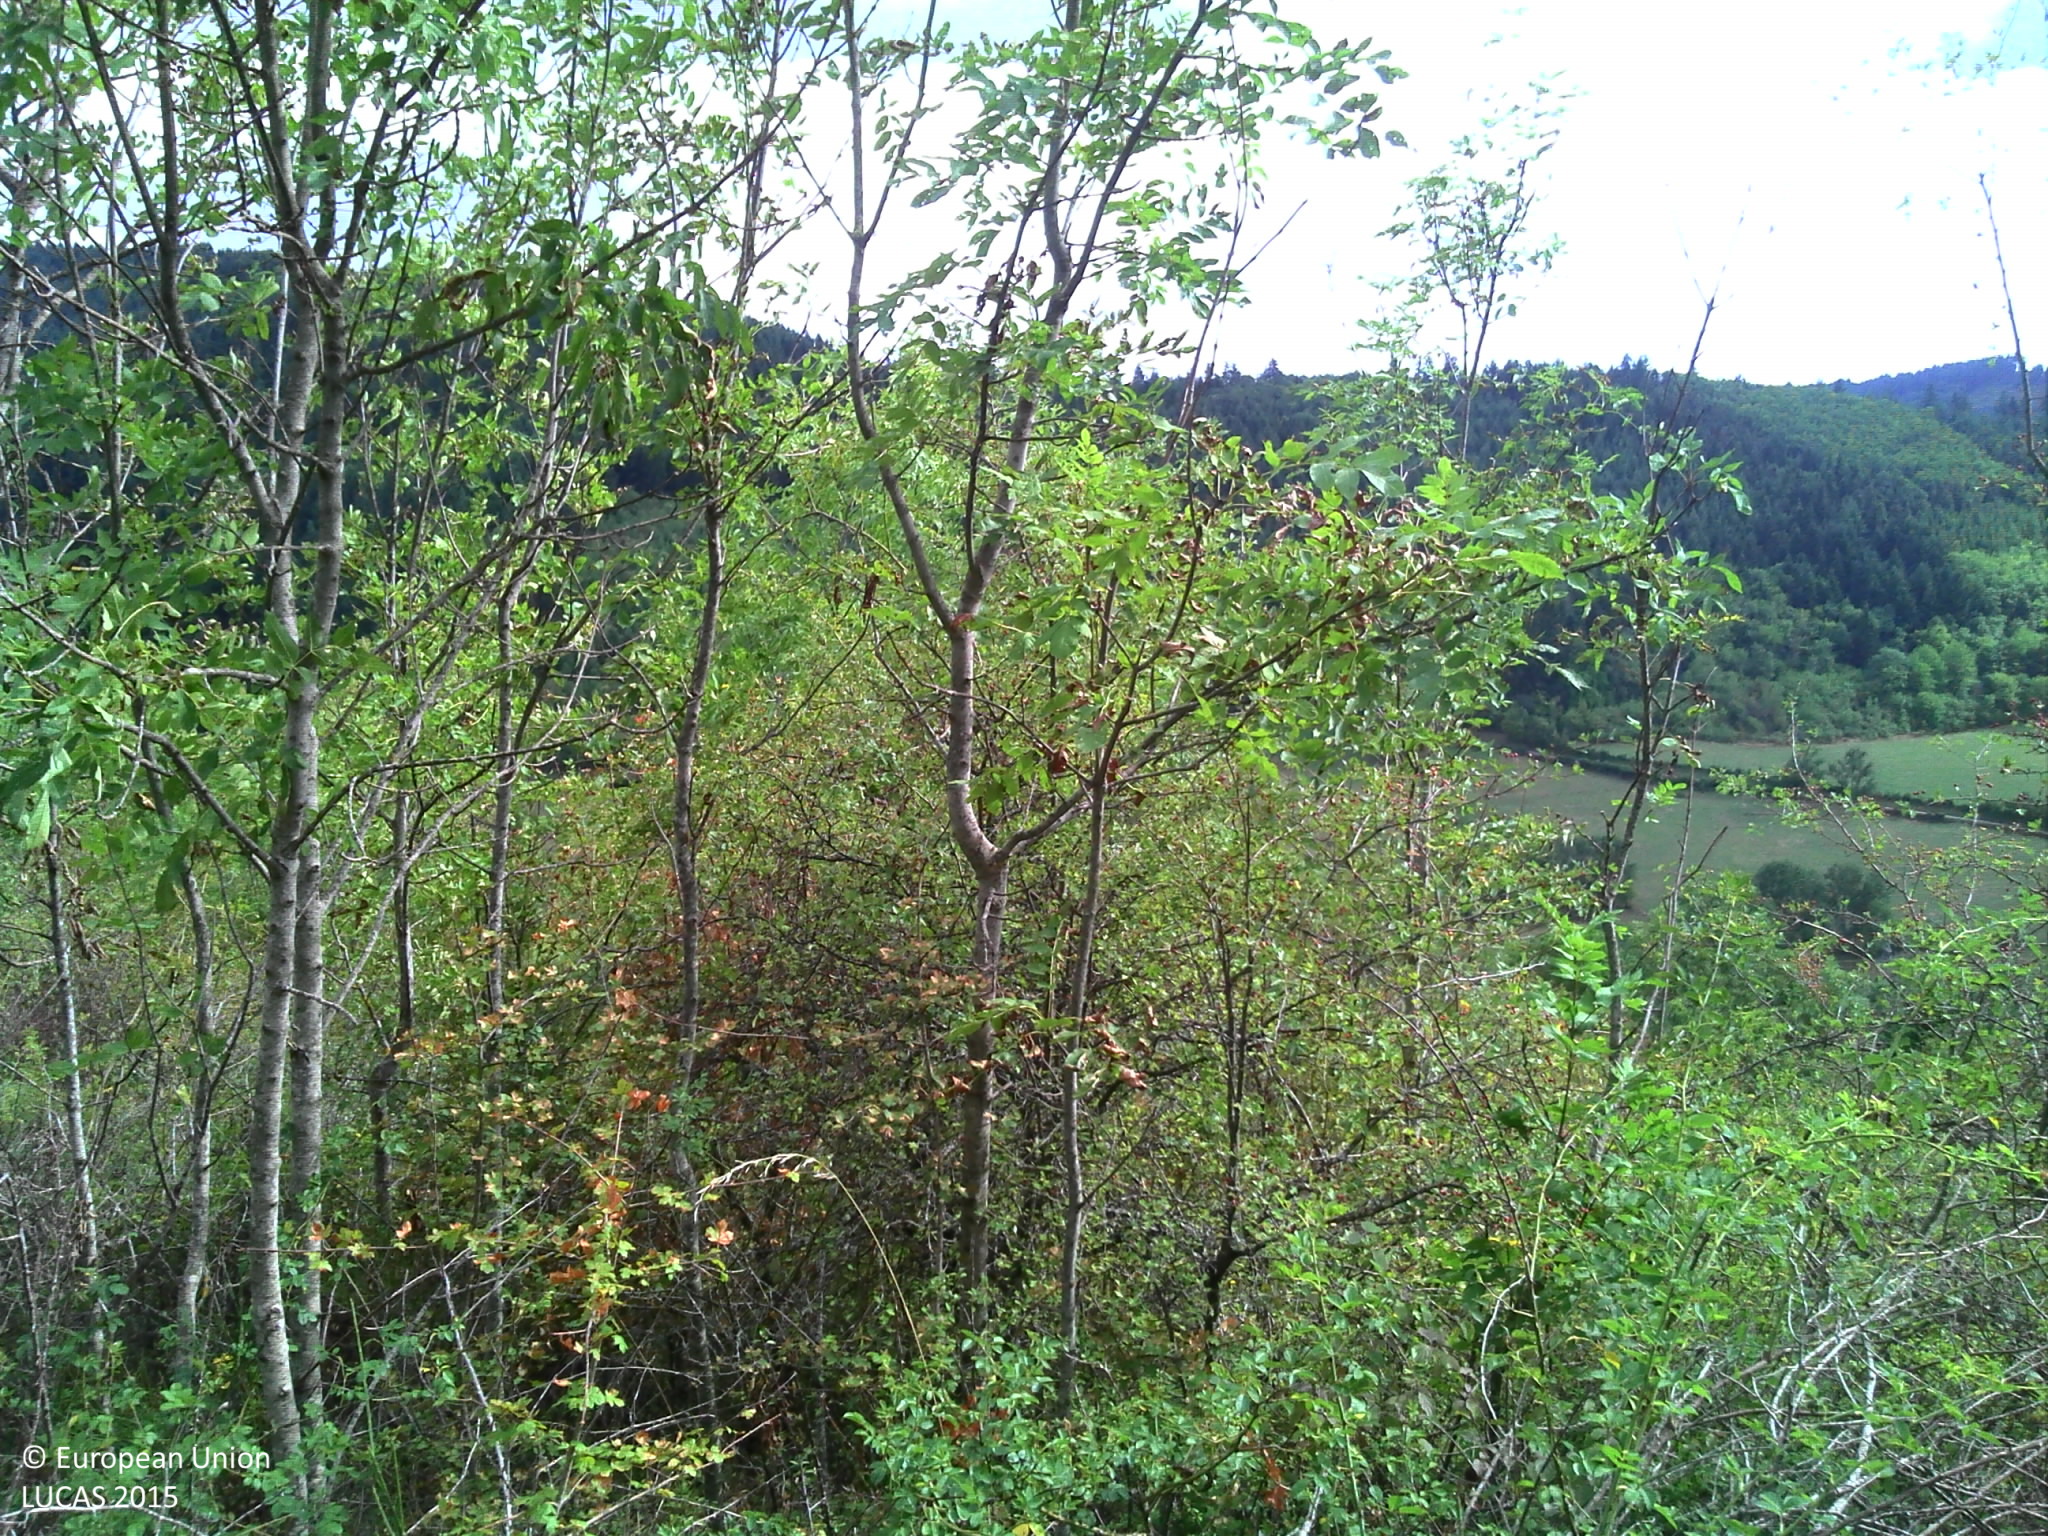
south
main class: Shrubland
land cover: Shrubland with sparse tree cover
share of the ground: > 75 %
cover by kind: shrubs 60 %, herbaceous plants 30 %, broadleaved forest trees 5 %, lichens and mosses 5 %
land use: Semi-natural and natural areas not in use
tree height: < 5 m
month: August
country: FR
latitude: 46.0311
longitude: 4.5375
